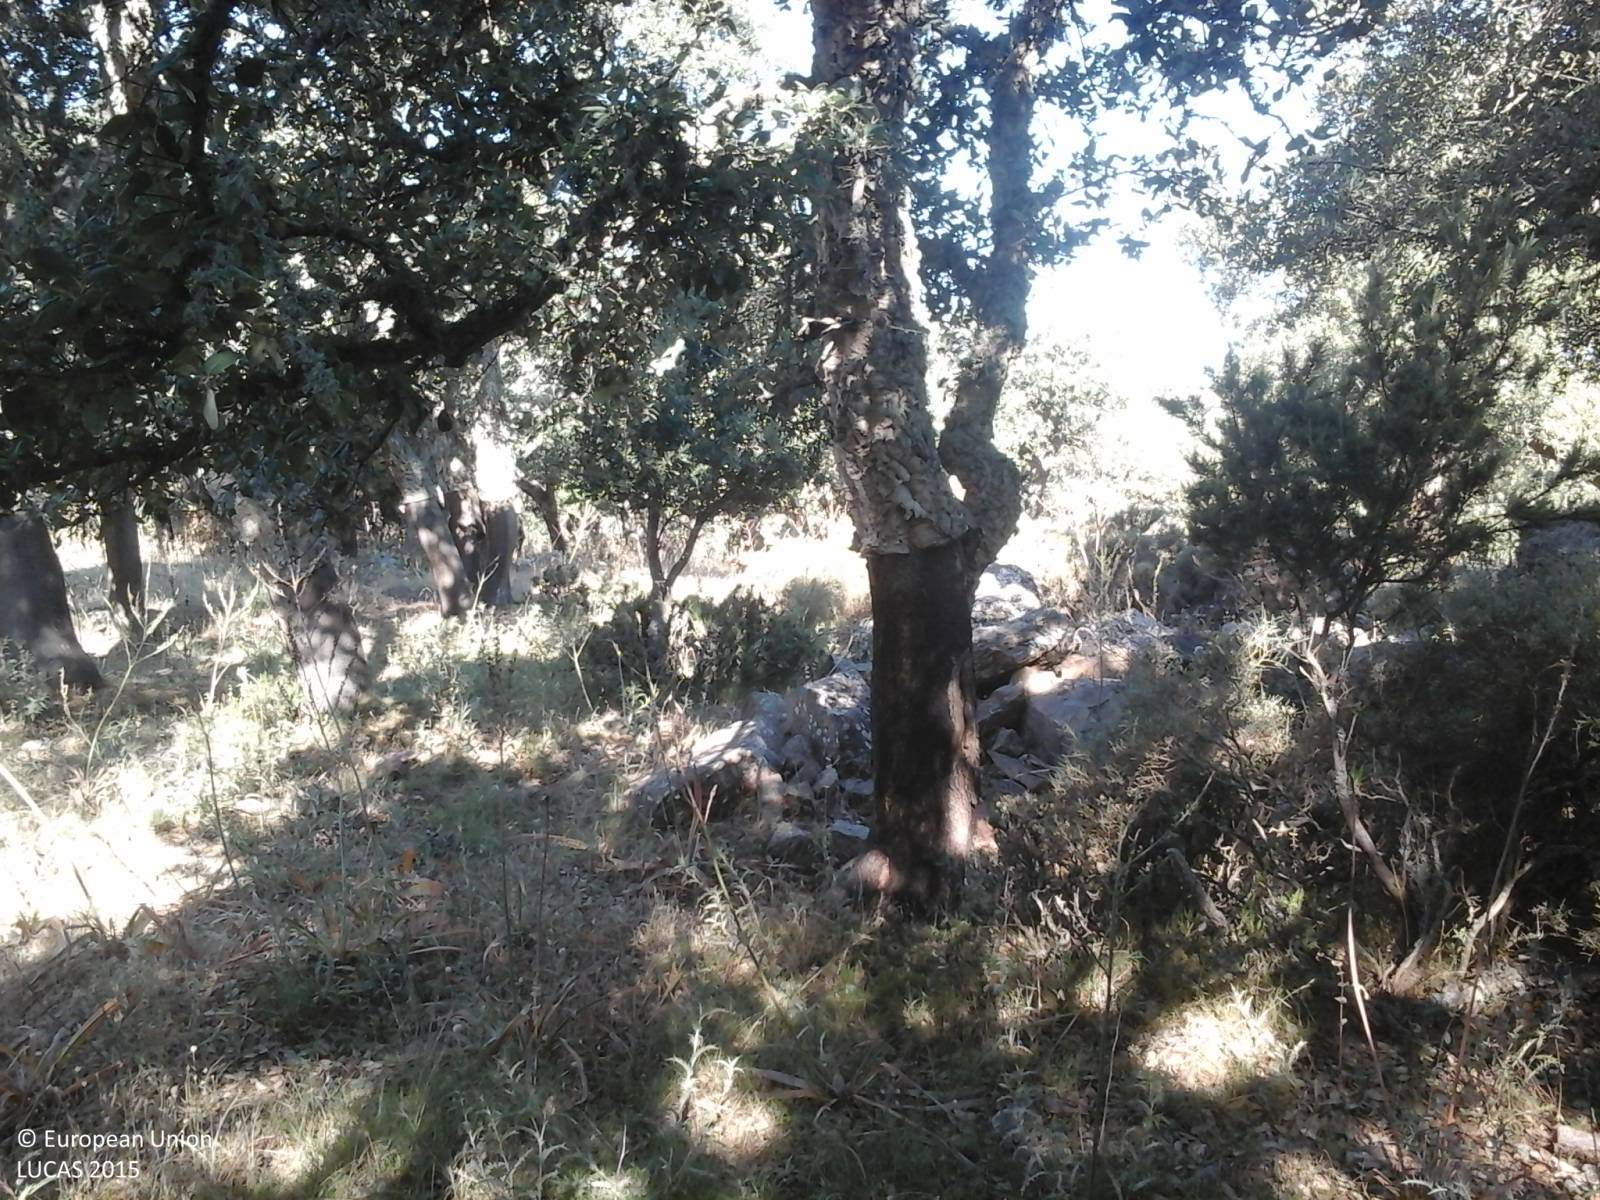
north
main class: Woodland
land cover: Broadleaved woodland
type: broadleaved evergreen forest
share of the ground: > 75 %
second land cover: Grassland without tree/shrub cover
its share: < 10 %
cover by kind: broadleaved forest trees 95 %, herbaceous plants 5 %
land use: Forestry
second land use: Agriculture (excluding fallow land and kitchen gardens)
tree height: > 5 m
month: July
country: IT
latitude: 40.5551
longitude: 9.4007
